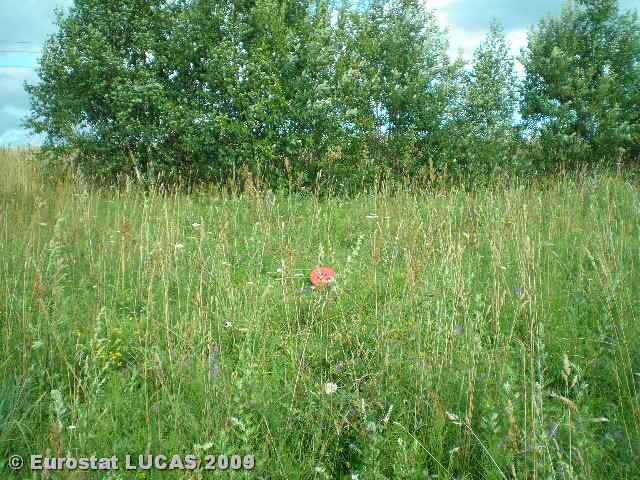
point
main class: Grassland
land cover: Spontaneously vegetated surfaces
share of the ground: > 75 %
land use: Fallow land
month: July
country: LT
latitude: 55.0189
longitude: 25.3399
